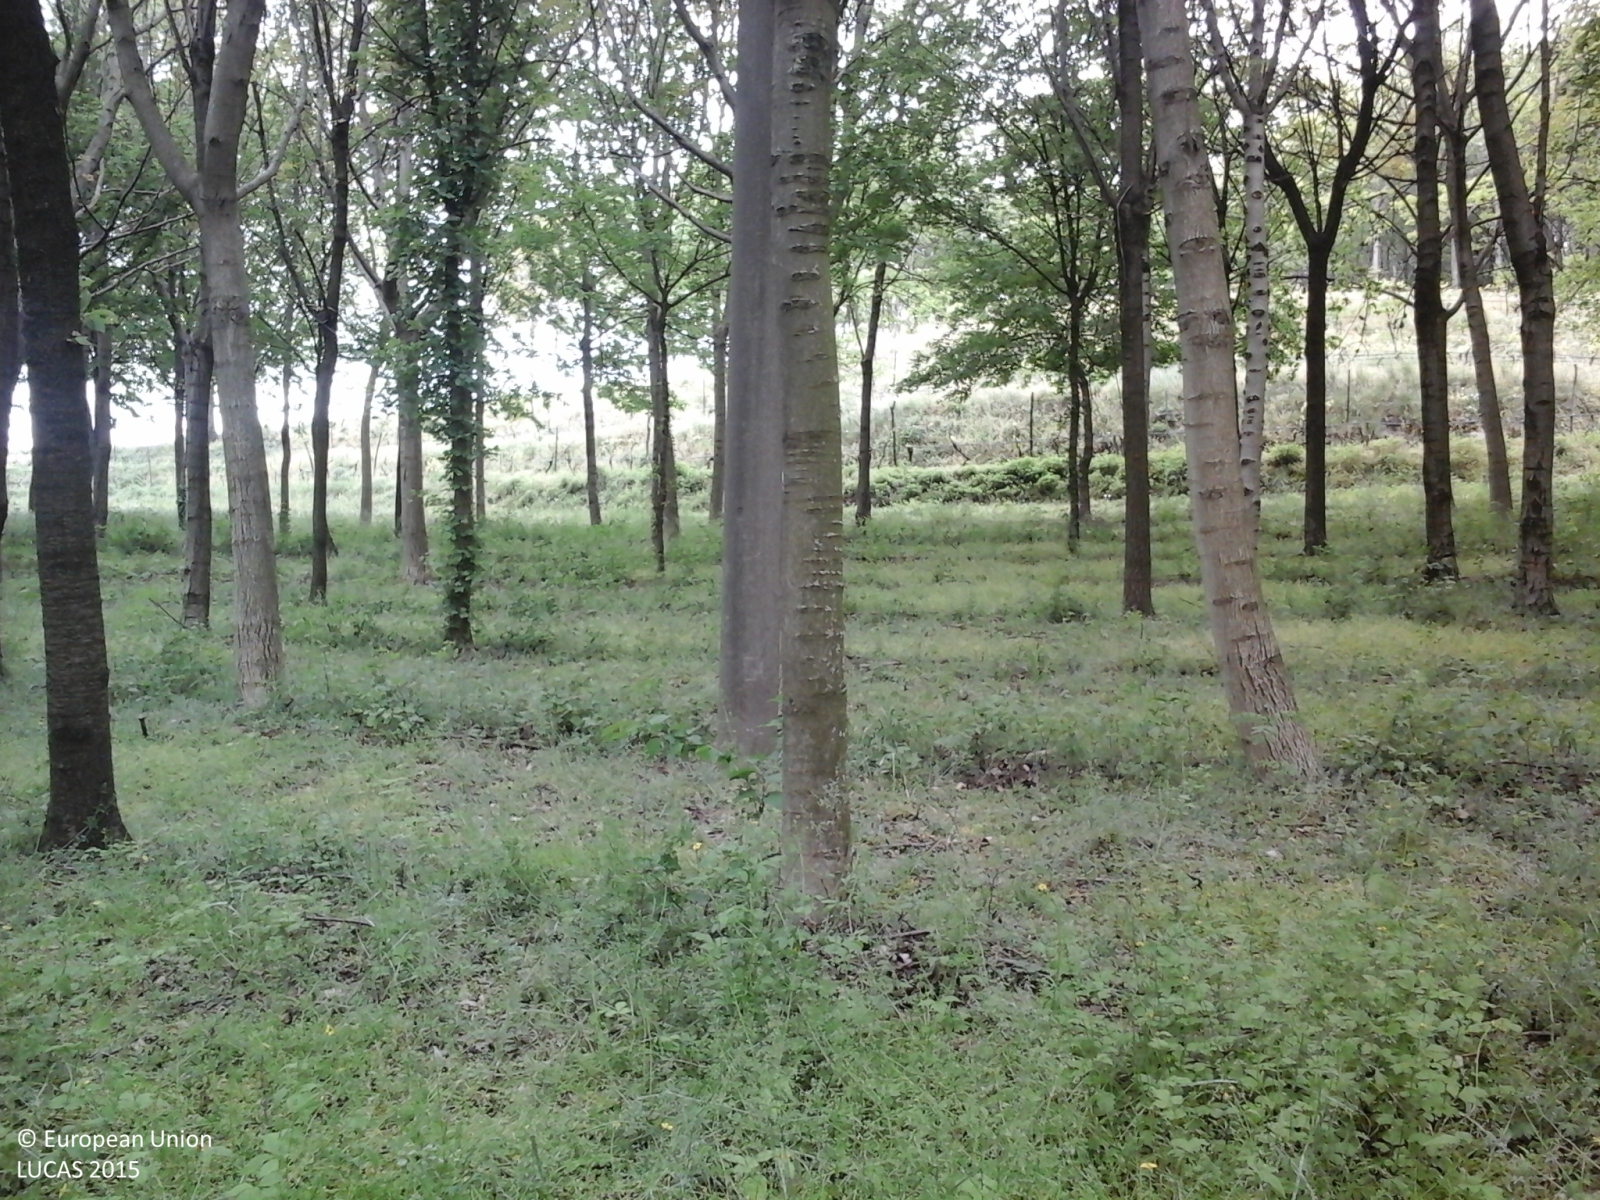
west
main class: Woodland
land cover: Broadleaved woodland
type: non-riverine alder, birch or aspen forest
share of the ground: > 75 %
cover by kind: broadleaved forest trees 100 %
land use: Forestry
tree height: > 5 m
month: April
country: IT
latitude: 45.3587
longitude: 10.5734
